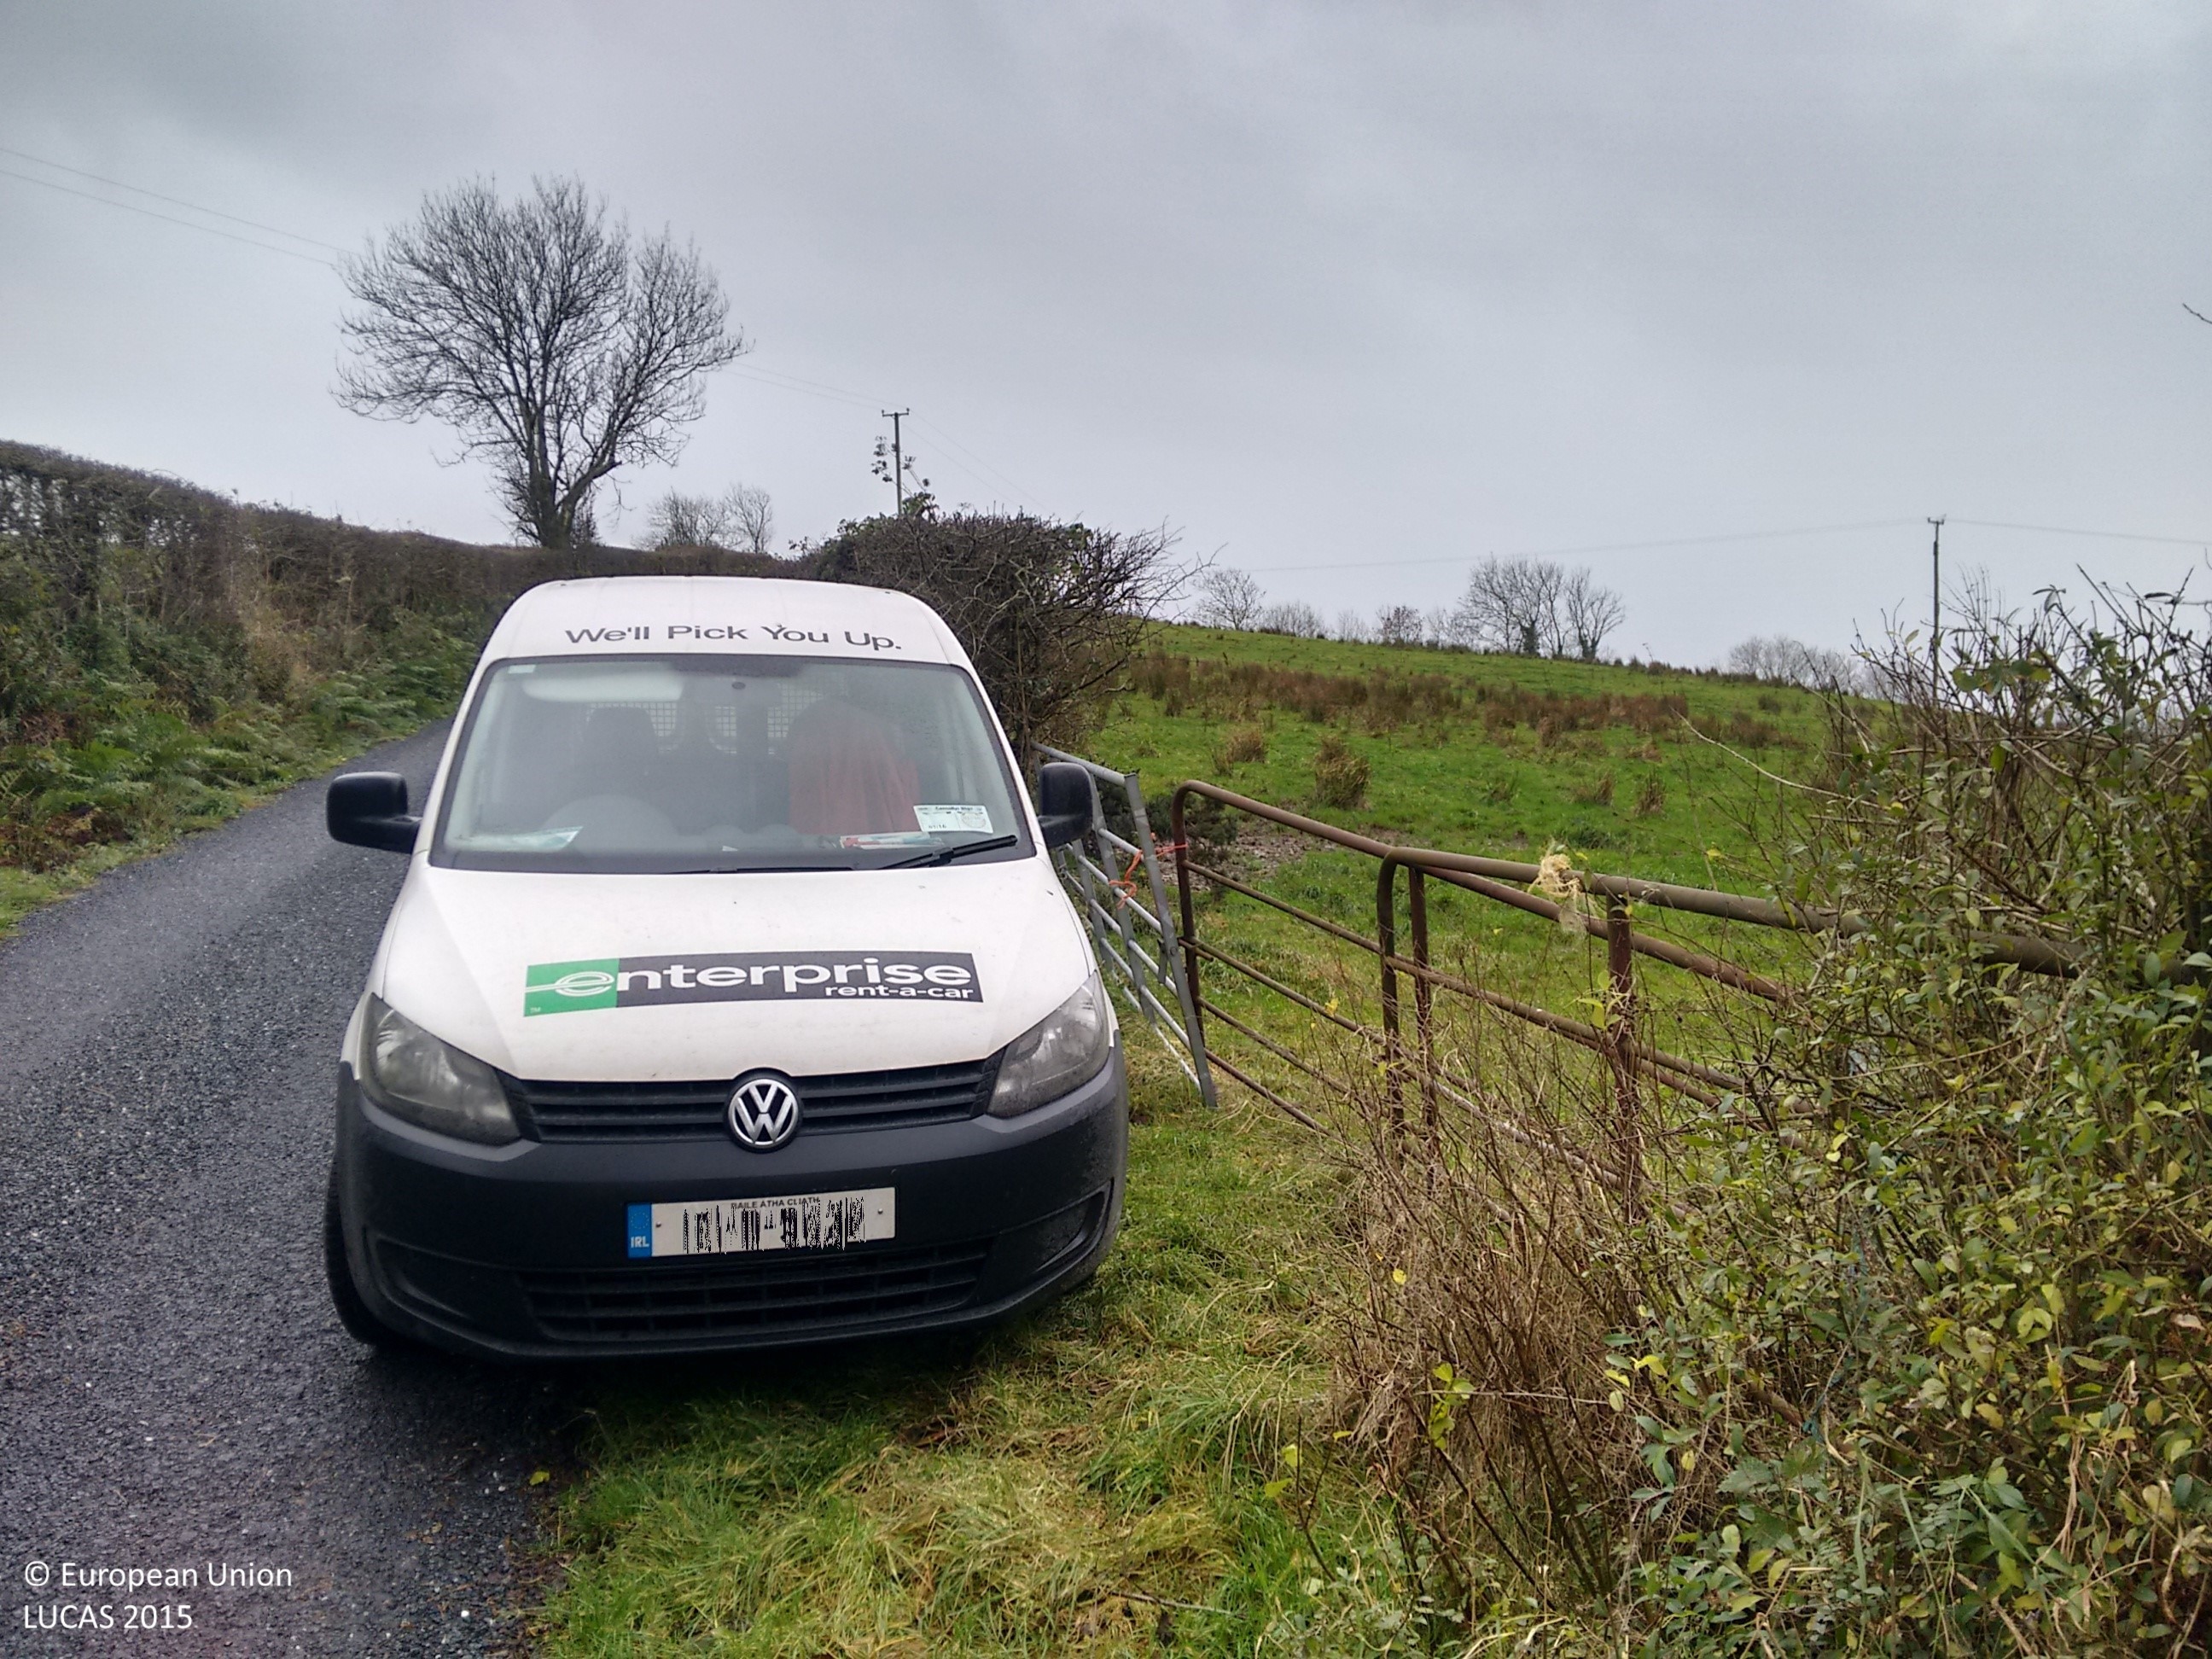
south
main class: Grassland
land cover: Grassland without tree/shrub cover
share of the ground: > 75 %
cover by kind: herbaceous plants 100 %
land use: Agriculture (excluding fallow land and kitchen gardens)
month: December
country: IE
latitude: 54.0602
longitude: -6.8972
